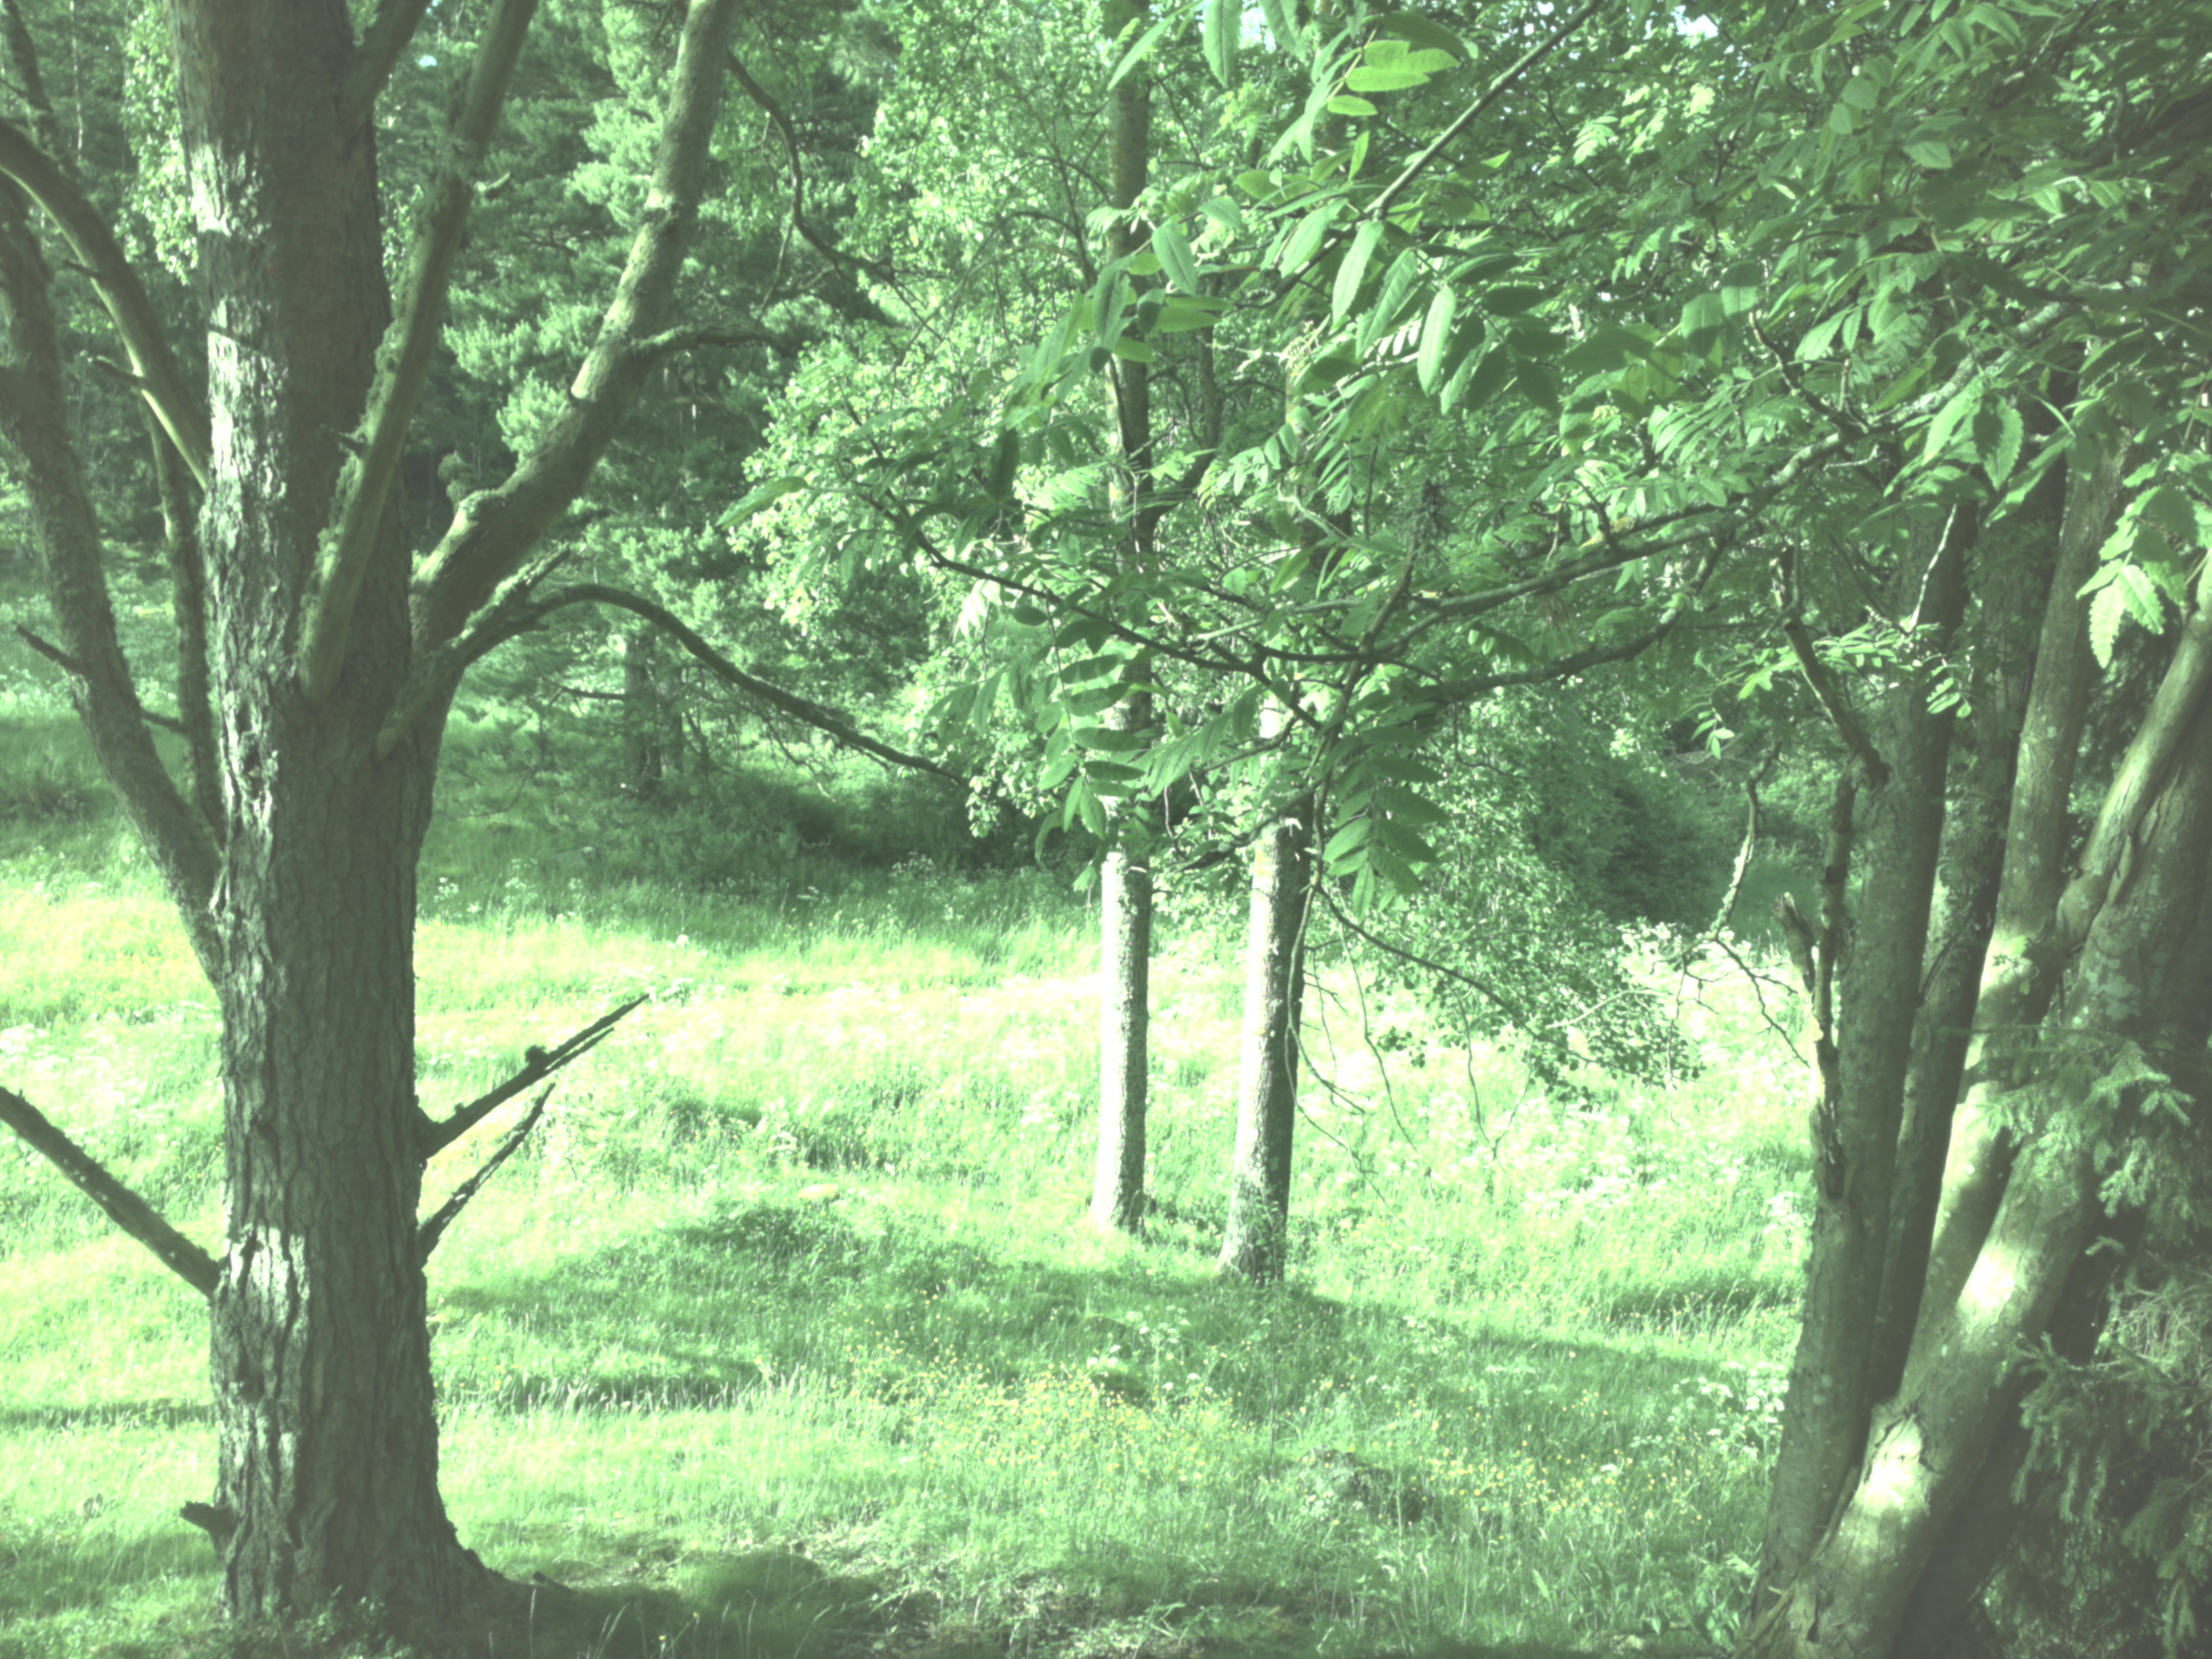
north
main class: Woodland
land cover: Pine dominated coniferous woodland
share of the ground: 50 - 75 %
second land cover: Grassland without tree/shrub cover
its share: 25 - 50 %
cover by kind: coniferous forest trees 50 %, herbaceous plants 30 %, broadleaved forest trees 10 %, shrubs 10 %
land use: Forestry
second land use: Agriculture (excluding fallow land and kitchen gardens)
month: June
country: SE
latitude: 59.2084
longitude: 17.4045
